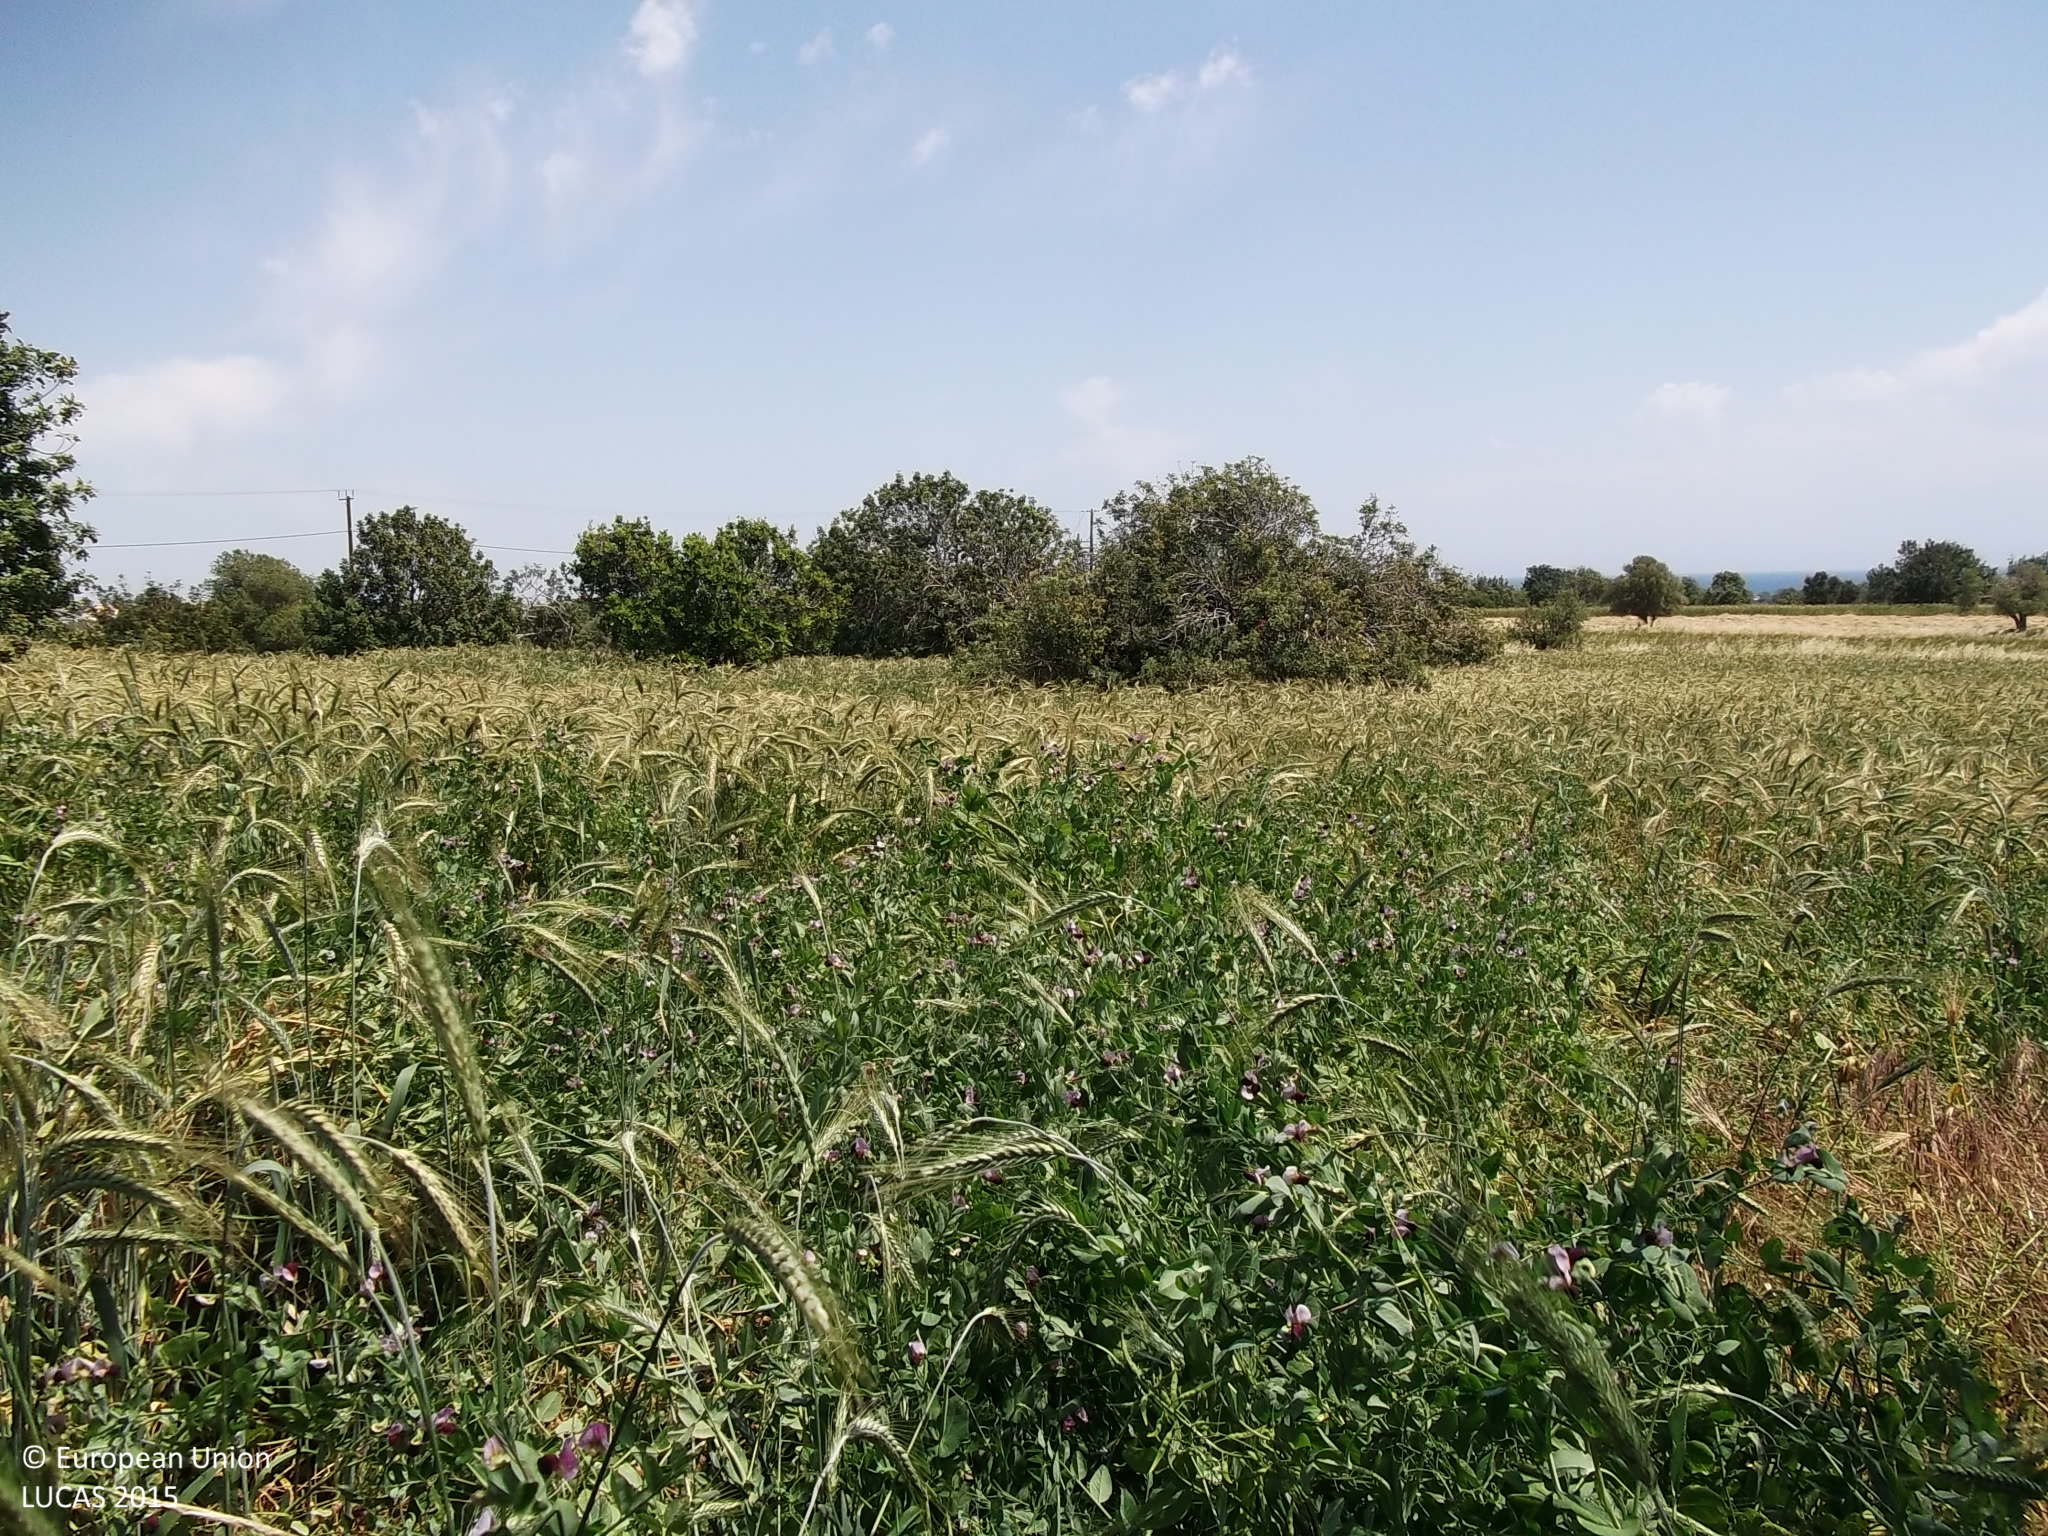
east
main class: Cropland
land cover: Permanent industrial crops
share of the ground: 25 - 50 %
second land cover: Common wheat
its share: > 75 %
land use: Agriculture (excluding fallow land and kitchen gardens)
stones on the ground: 25 - 50 %
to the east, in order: Permanent industrial crops; Common wheat; Grass margins; Mixed cereals for fodder; Single bushes/trees; Mixed cereals for fodder; Grassland without tree/shrub cover; Electric lines; Mixed cereals for fodder; Permanent industrial crops; Grassland without tree/shrub cover; Tracks; Other bare soil
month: April
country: CY
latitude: 34.8015
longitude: 33.4790
